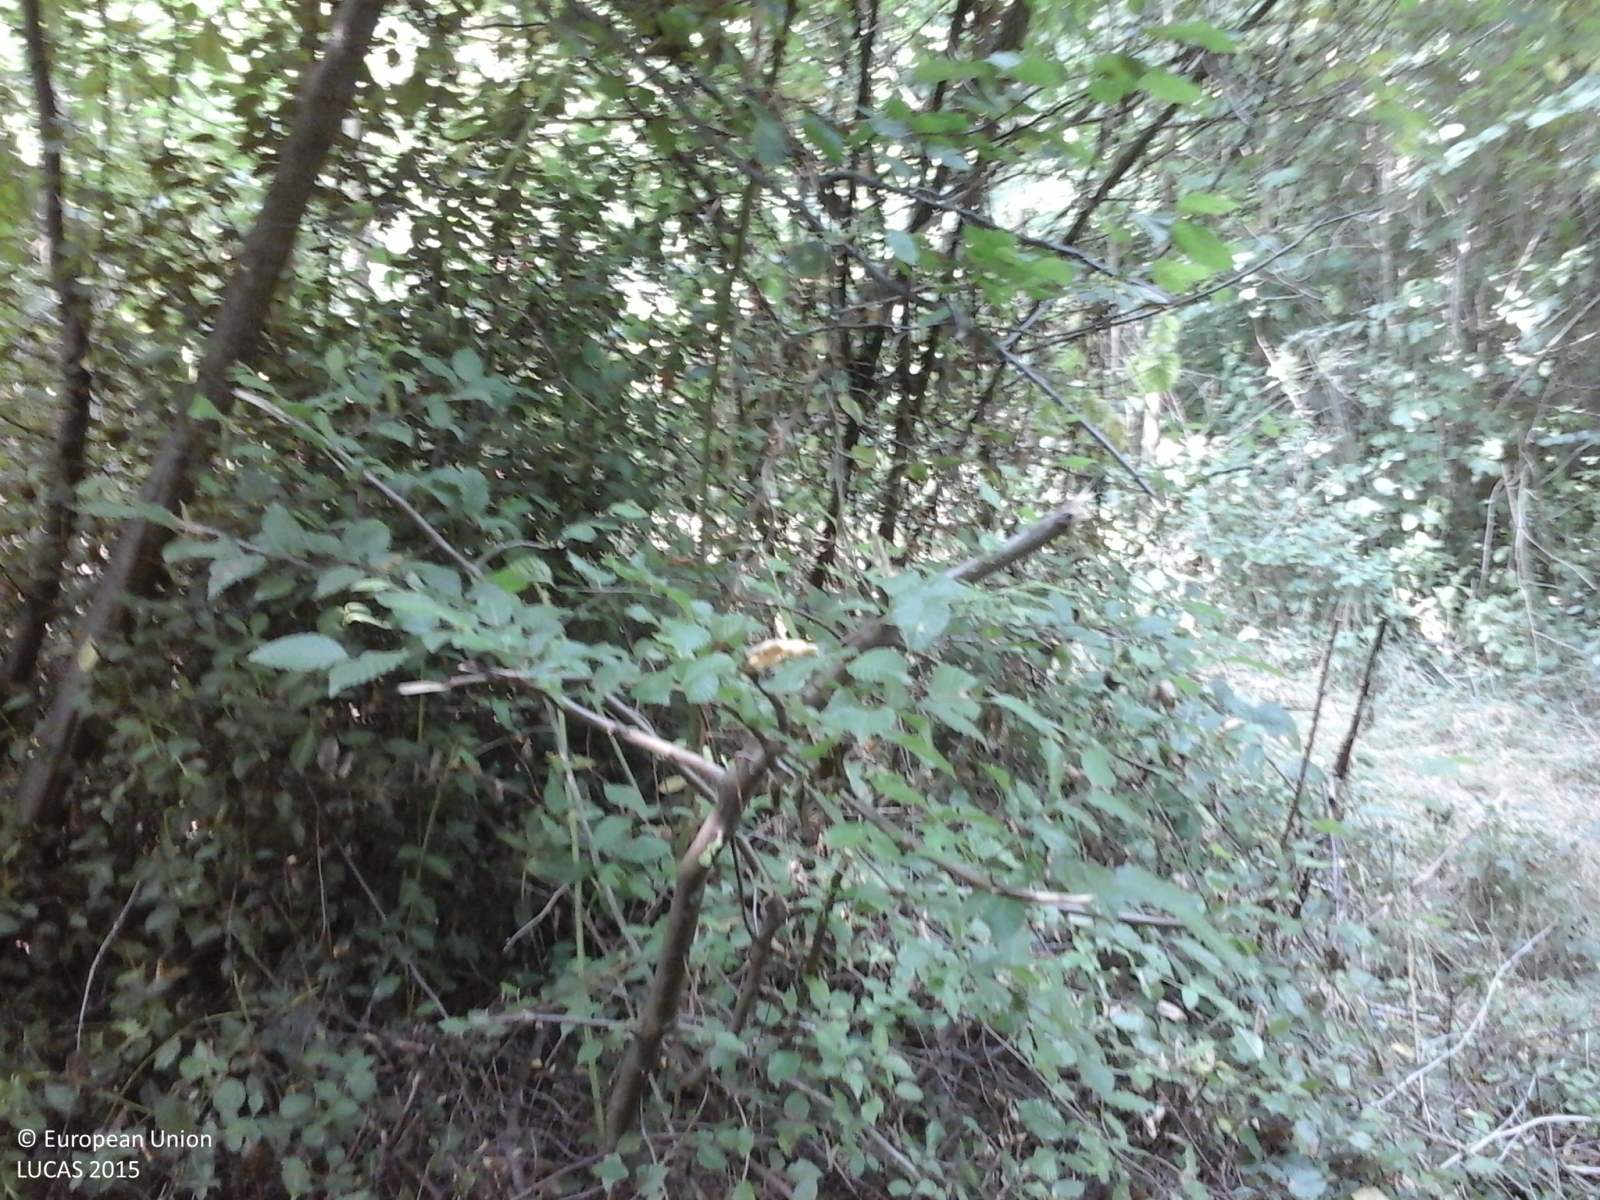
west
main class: Woodland
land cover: Broadleaved woodland
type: thermophilous deciduous forest
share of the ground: > 75 %
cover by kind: broadleaved forest trees 100 %
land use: Forestry
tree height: > 5 m
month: July
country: IT
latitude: 45.3907
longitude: 7.7683
